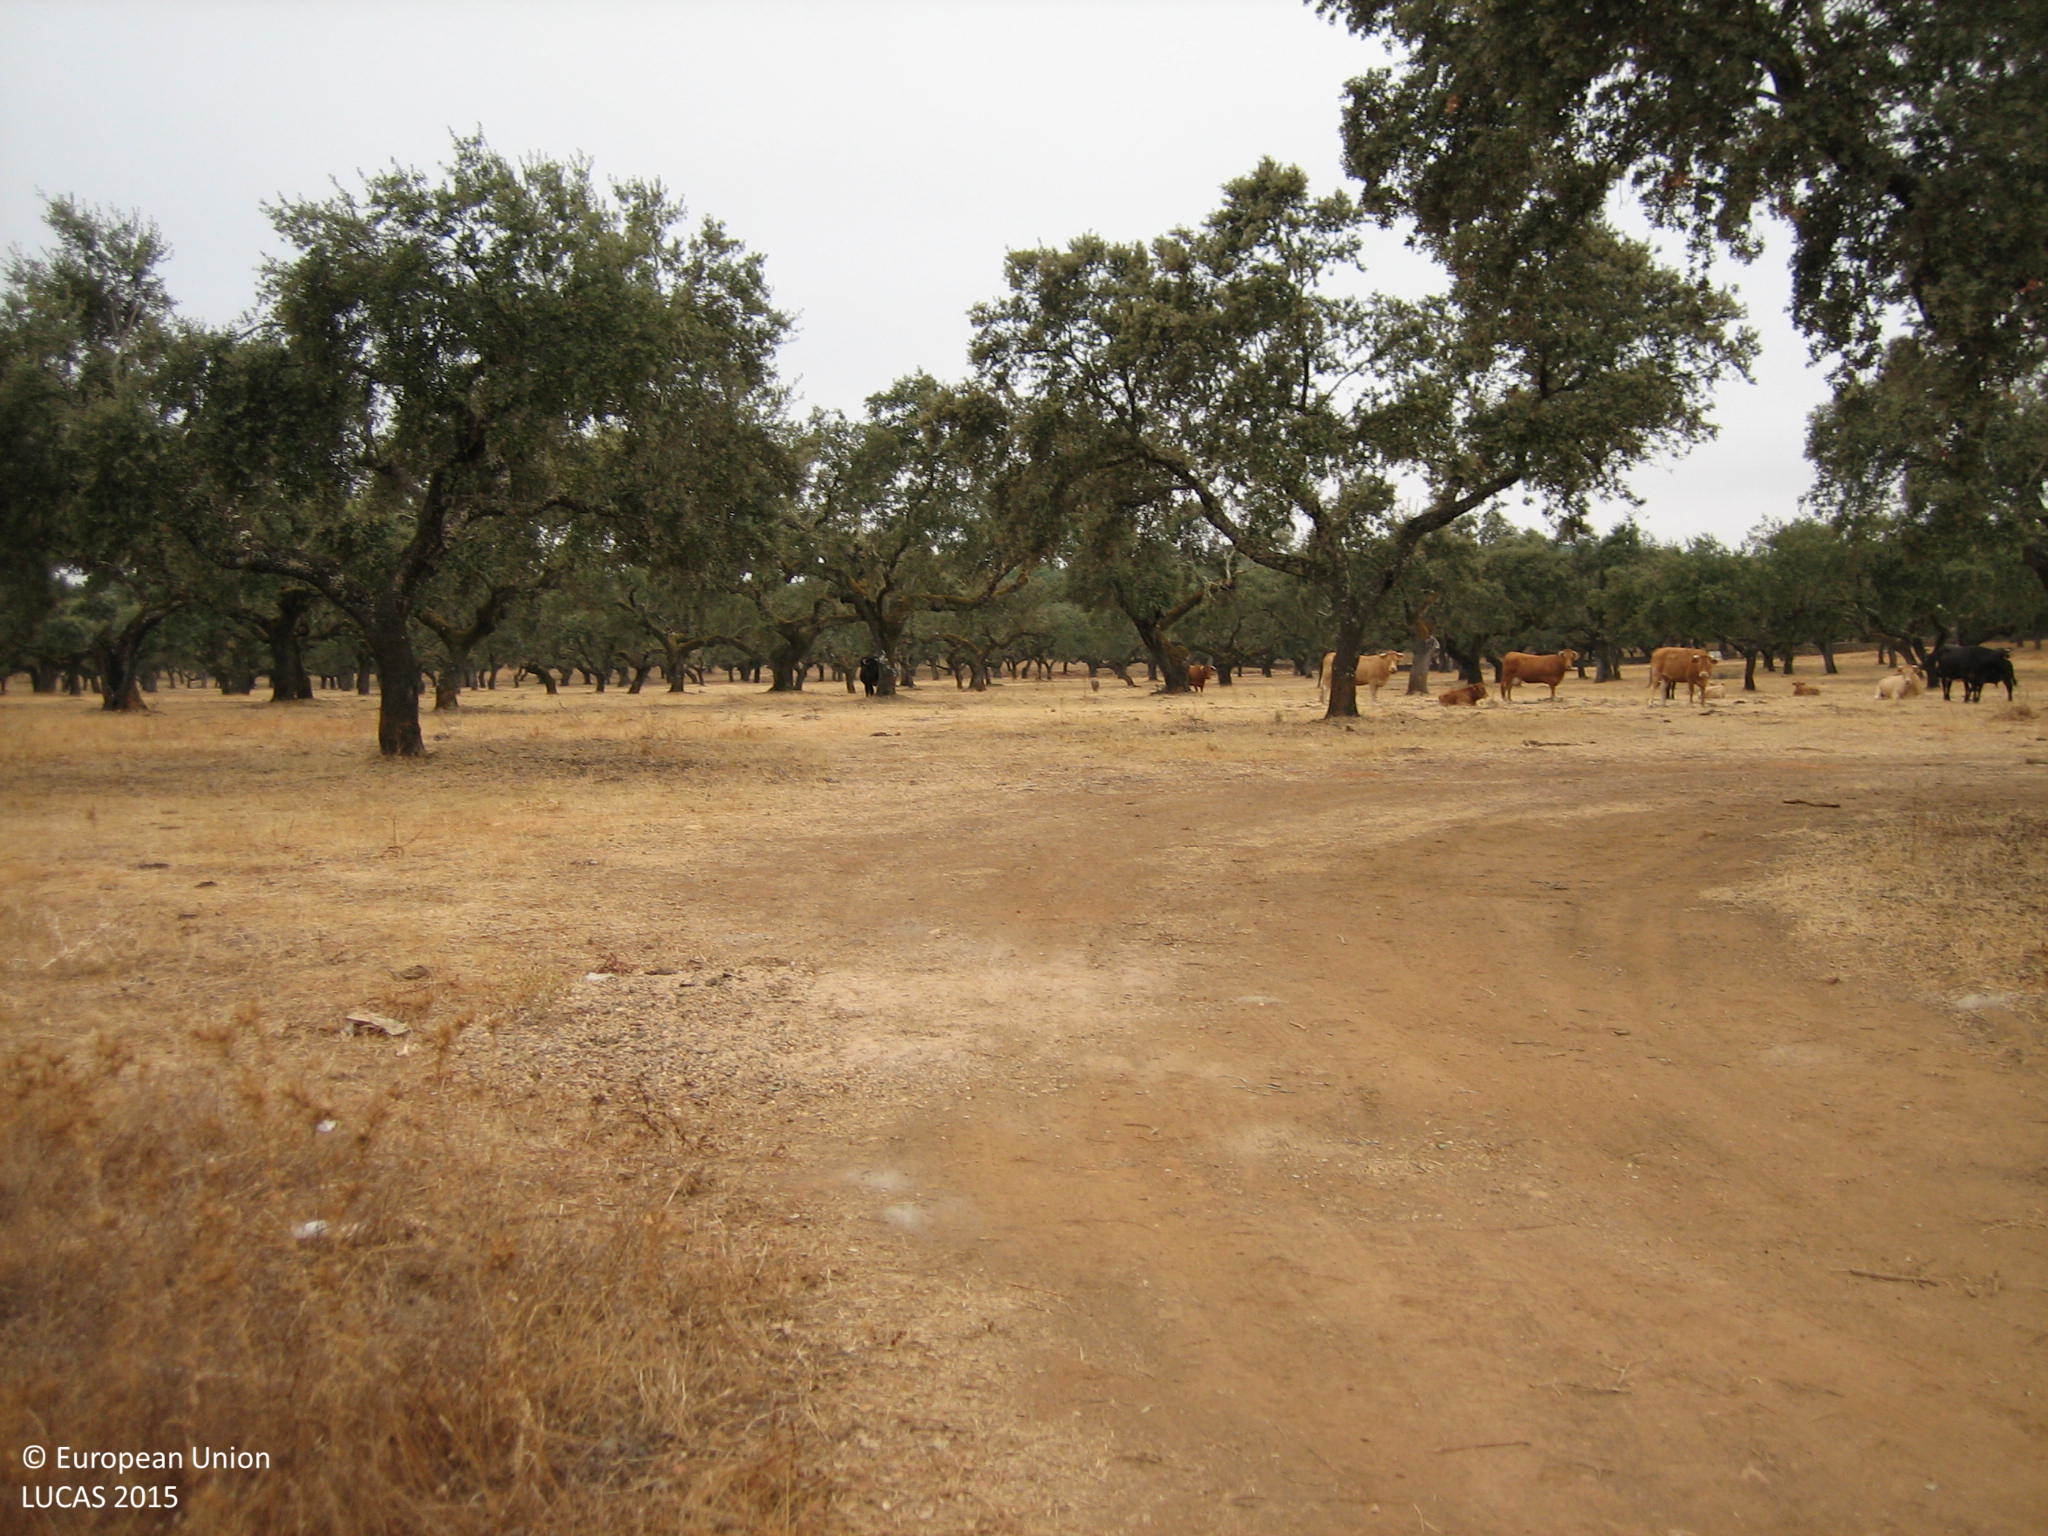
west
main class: Woodland
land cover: Broadleaved woodland
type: broadleaved evergreen forest
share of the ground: > 75 %
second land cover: Grassland without tree/shrub cover
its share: > 75 %
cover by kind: broadleaved forest trees 85 %, herbaceous plants 15 %
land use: Forestry
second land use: Agriculture (excluding fallow land and kitchen gardens)
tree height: > 5 m
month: September
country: ES
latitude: 38.3170
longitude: -6.8587
